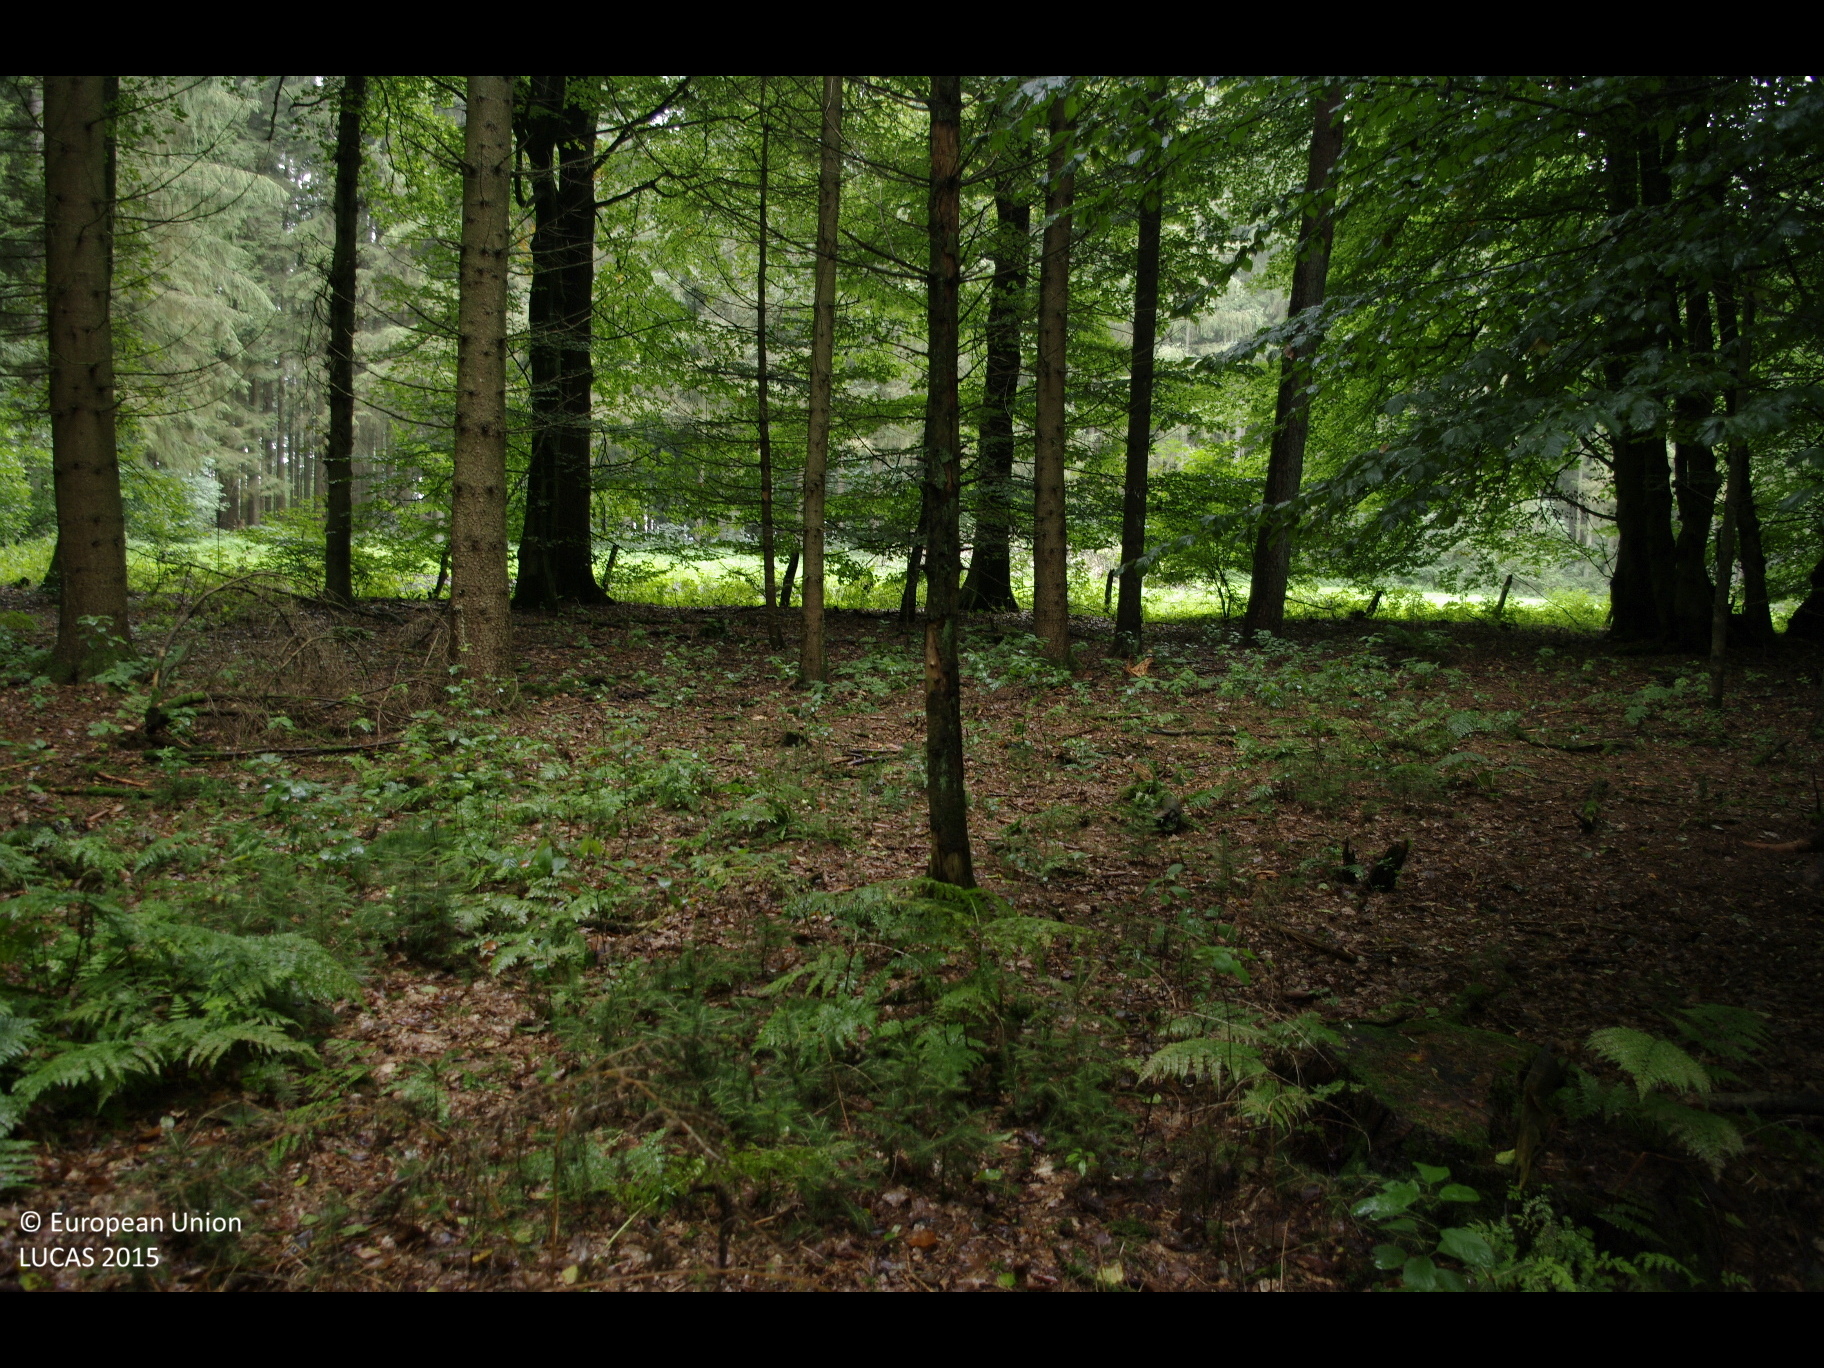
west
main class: Woodland
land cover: Pine dominated mixed woodland
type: hemiboreal forest and nemoral coniferous forest and mixed broadleaved-coniferous forest
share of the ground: > 75 %
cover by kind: coniferous forest trees 50 %, broadleaved forest trees 40 %, herbaceous plants 10 %
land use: Forestry
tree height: > 5 m
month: September
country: DE
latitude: 53.3839
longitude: 9.9249
